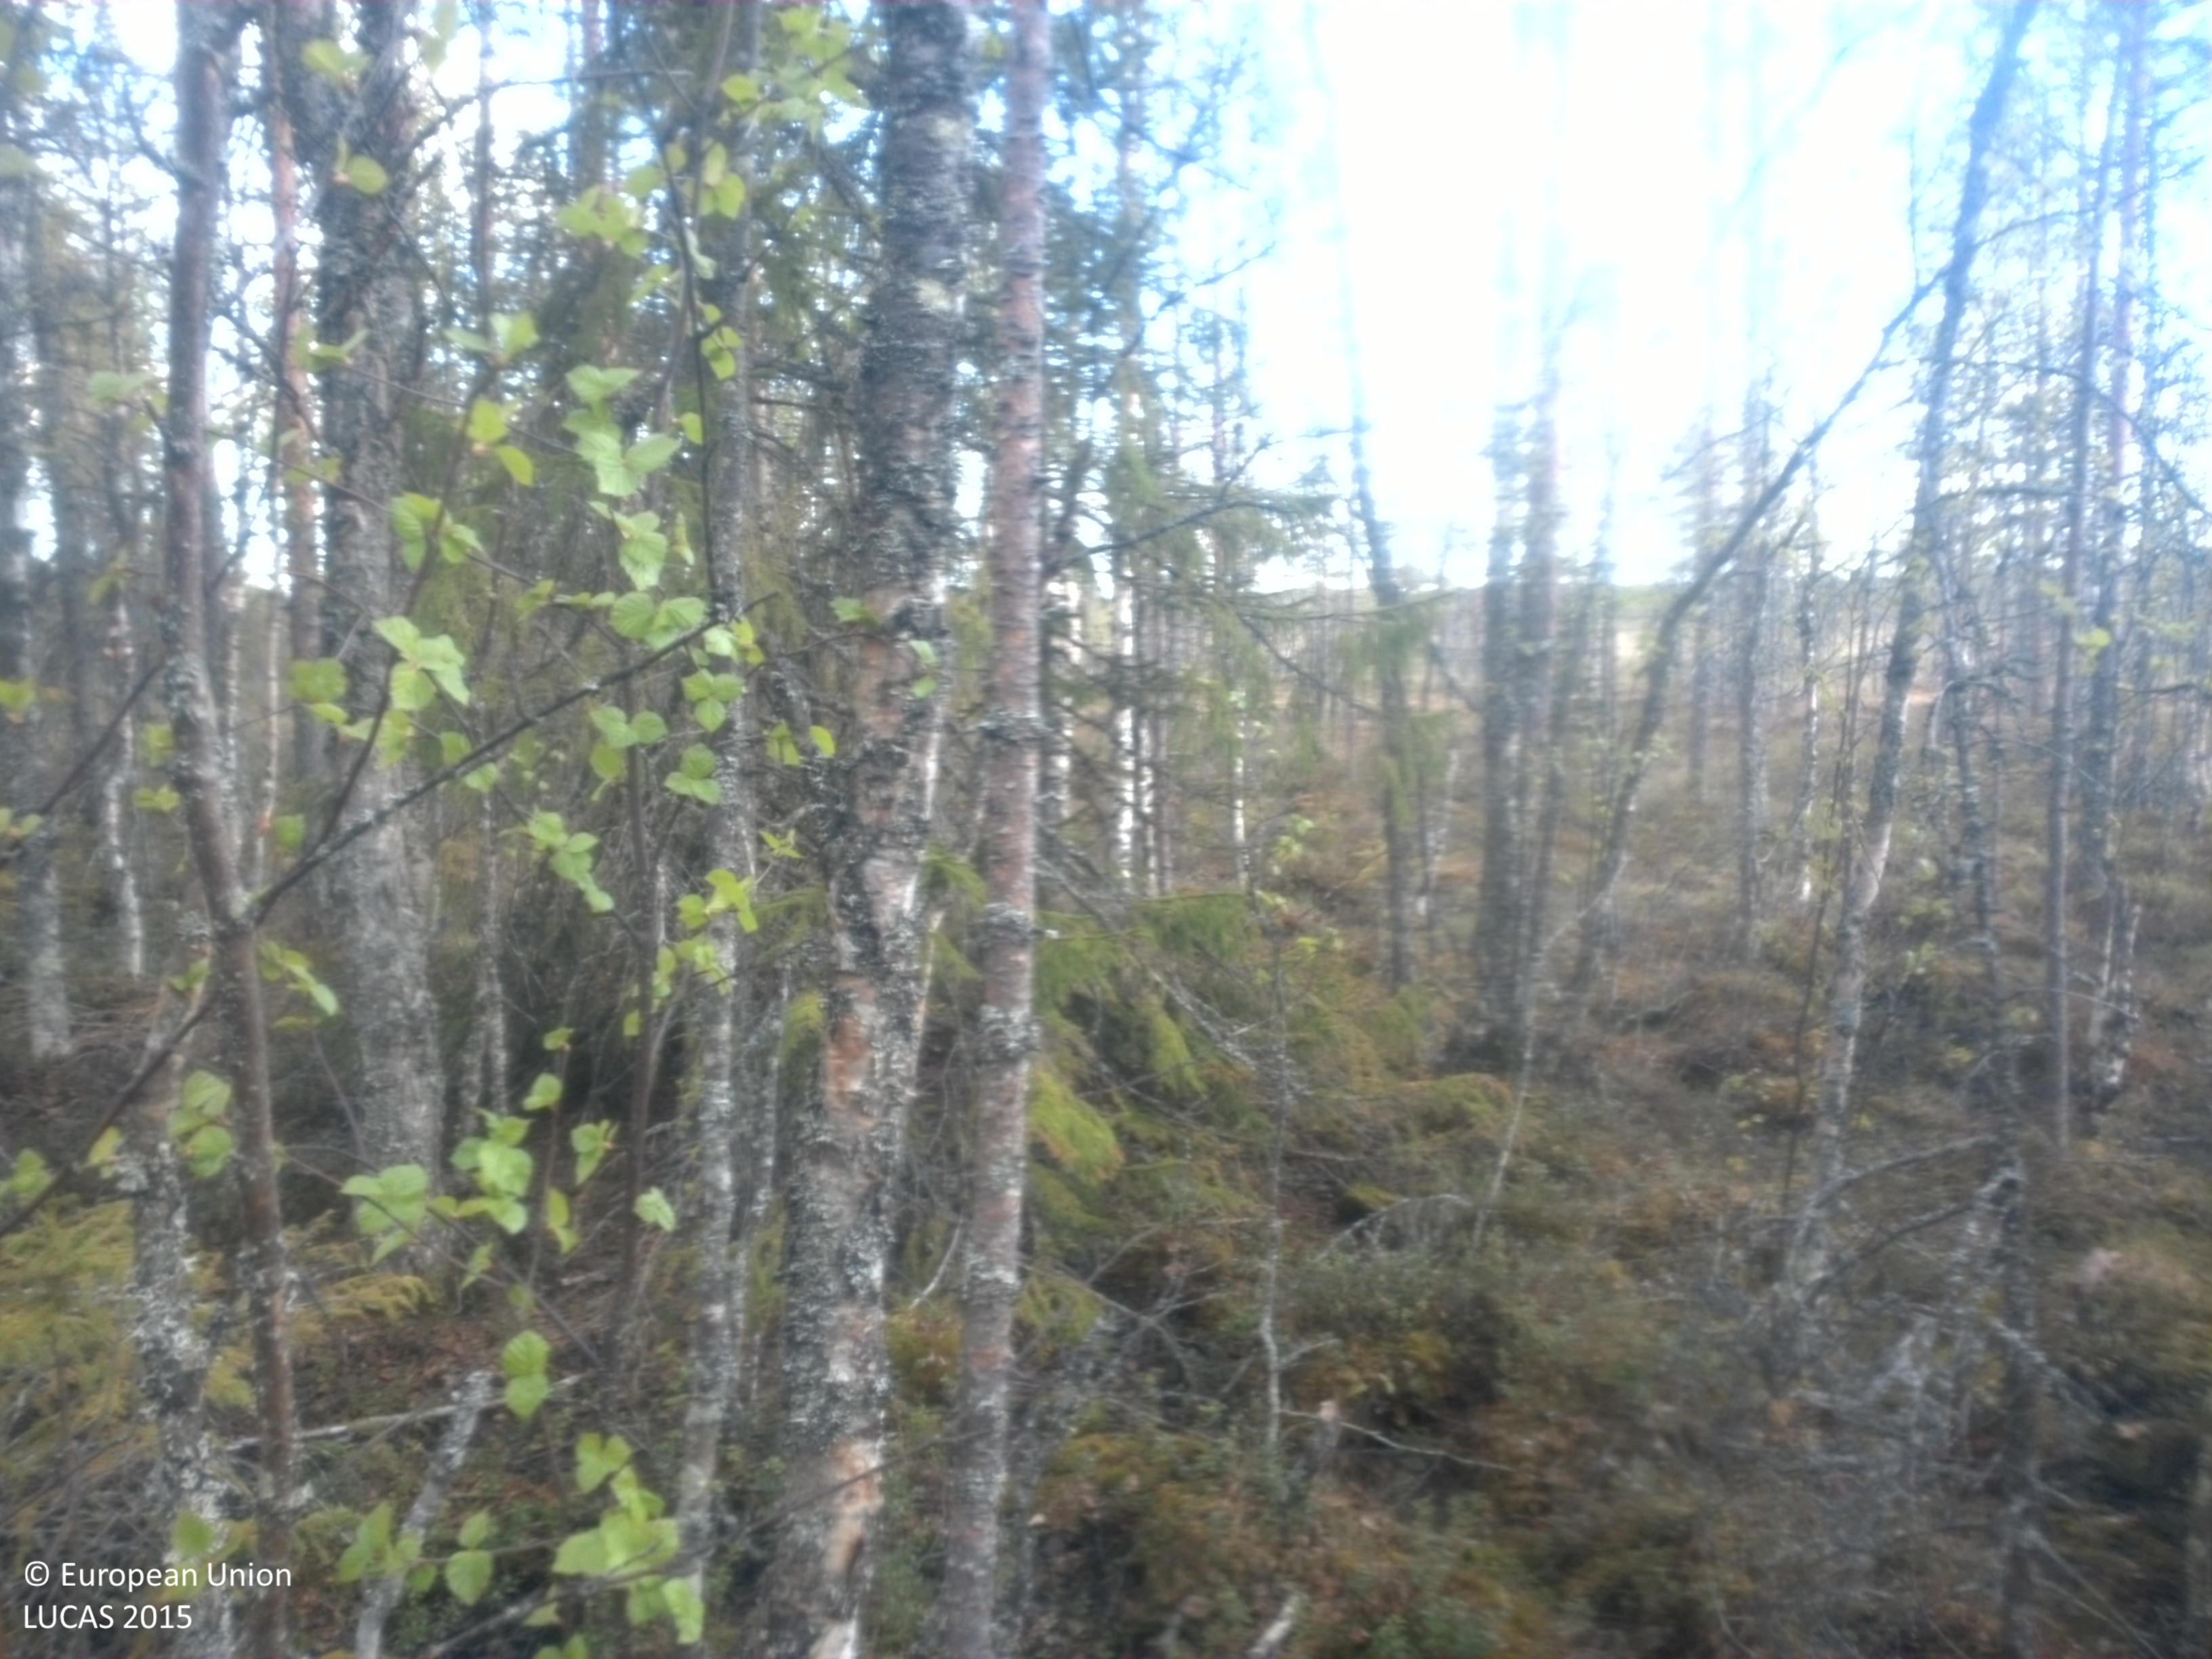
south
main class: Woodland
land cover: Pine dominated coniferous woodland
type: boreal forest
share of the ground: 50 - 75 %
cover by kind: coniferous forest trees 55 %, broadleaved forest trees 10 %, shrubs 10 %, herbaceous plants 10 %, lichens and mosses 10 %, unconsolidated bare surface 5 %
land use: Forestry
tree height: > 5 m
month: June
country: SE
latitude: 64.3945
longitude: 17.6620
